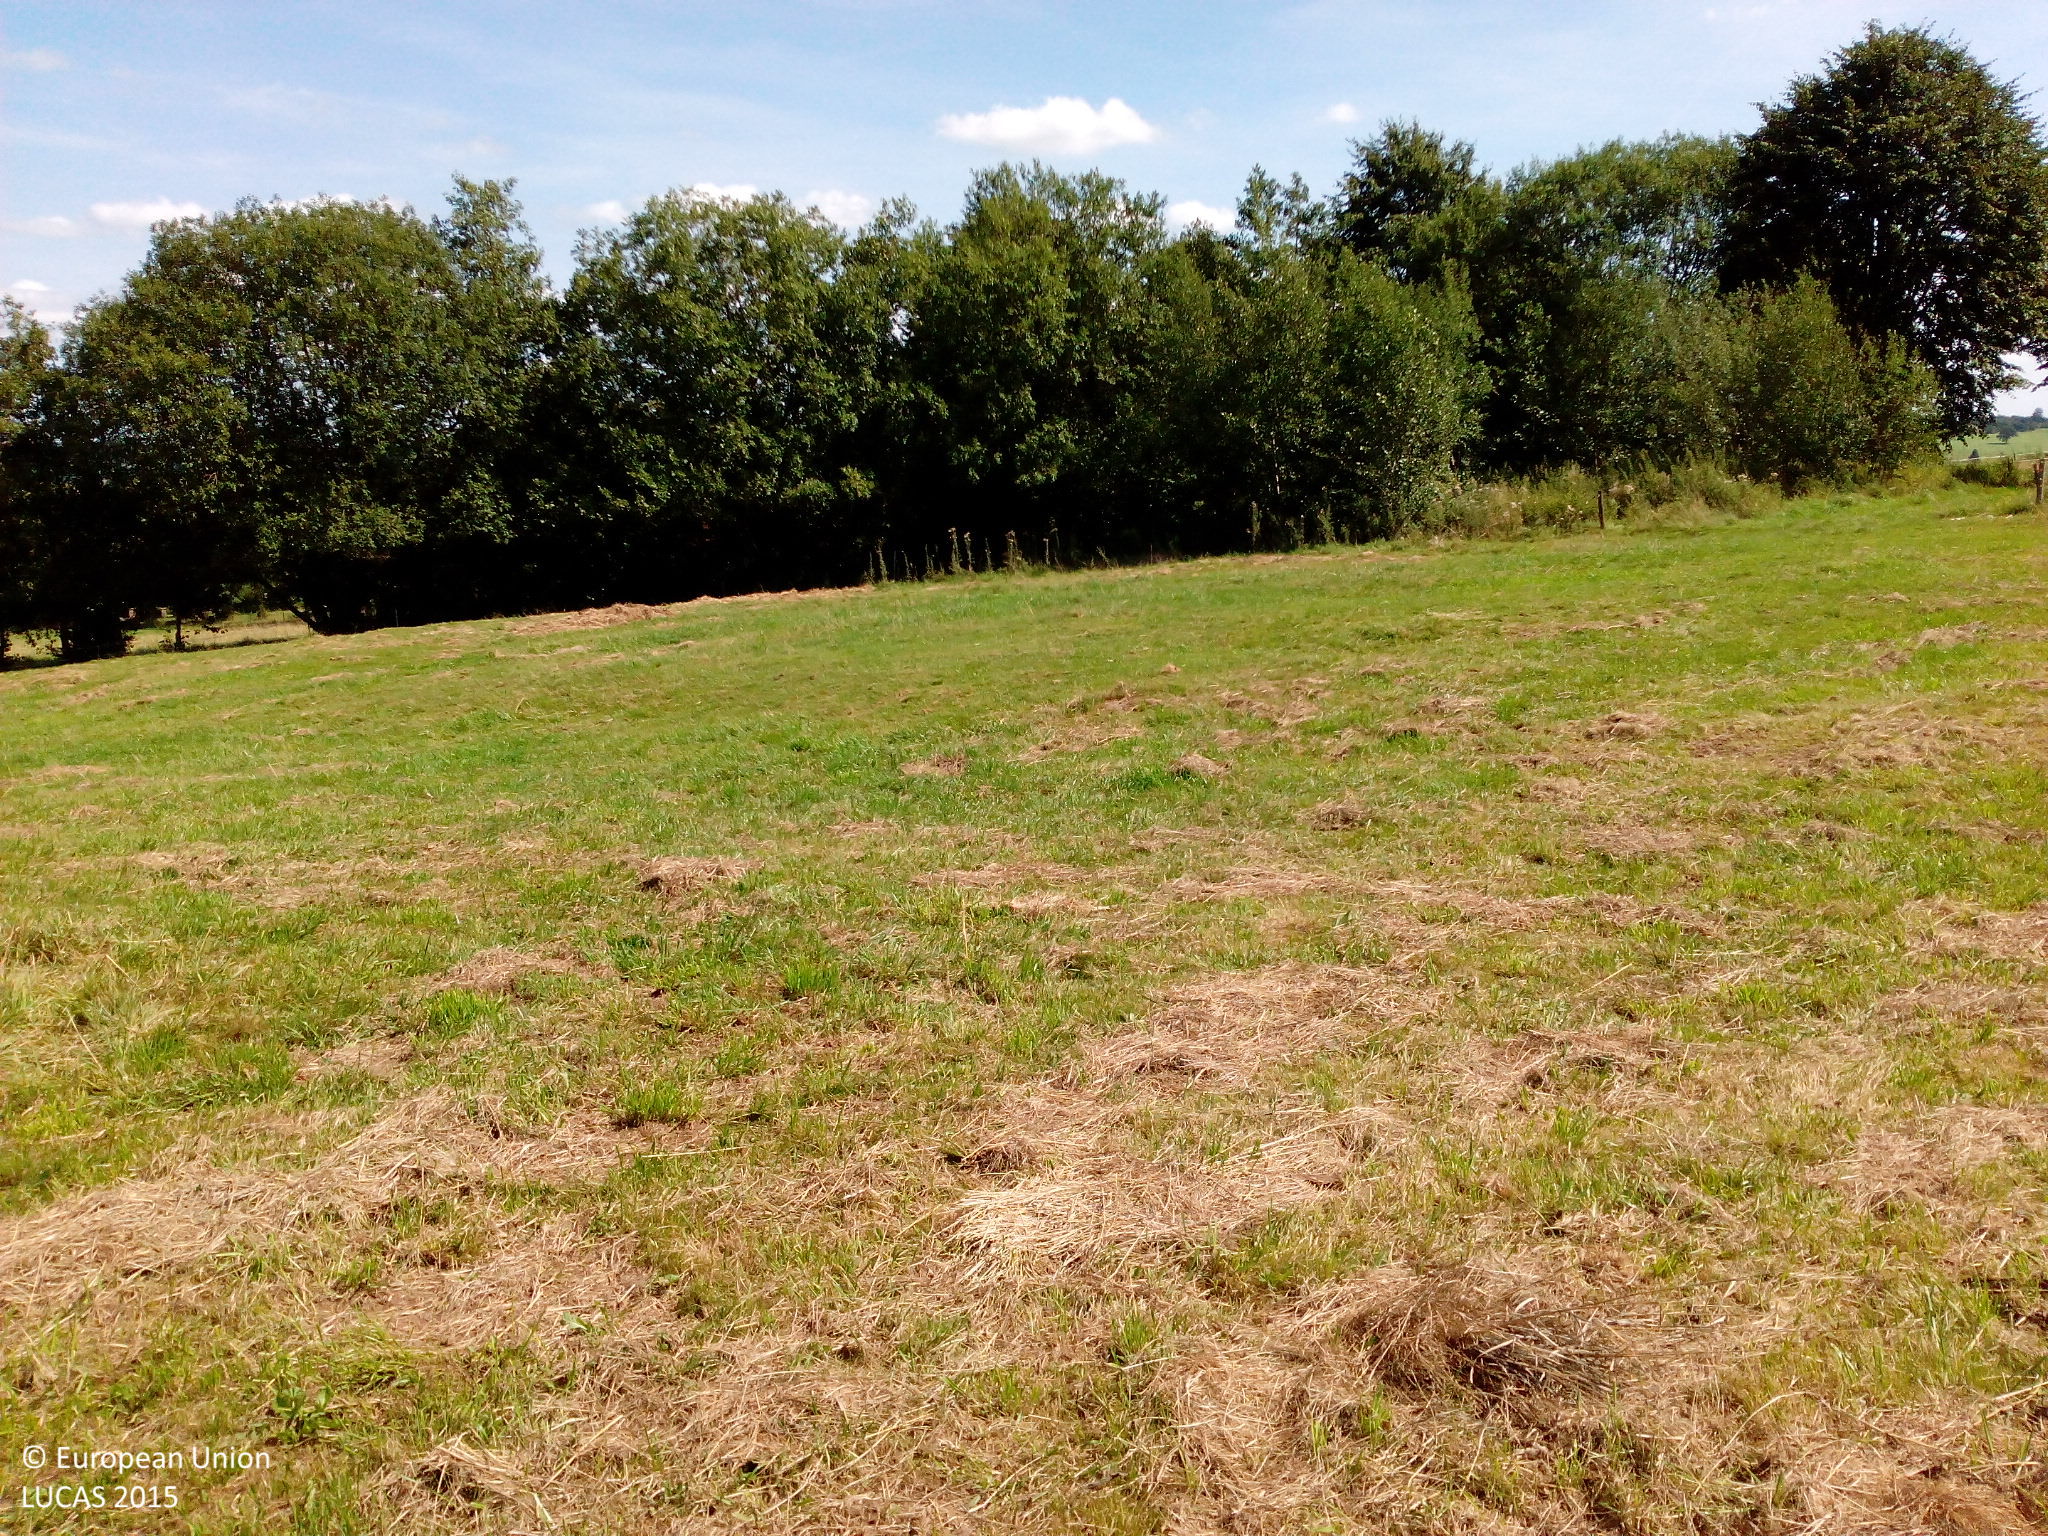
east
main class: Grassland
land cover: Grassland without tree/shrub cover
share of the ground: > 75 %
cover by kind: herbaceous plants 100 %
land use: Agriculture (excluding fallow land and kitchen gardens)
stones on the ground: < 10 %
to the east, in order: Grassland without tree/shrub cover; Fences; Broadleaved woodland; Ditches and canals; Fences; Grassland without tree/shrub cover; Lines of trees; Fences; Grass margins; Paved roads, cycling and walking lanes; Grass margins; Ditches and canals; Lines of trees; Grassland without tree/shrub cover; Apple fruit; Tracks; Grassland with sparse tree/shrub cover
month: August
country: DE
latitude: 50.4699
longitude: 9.3098
